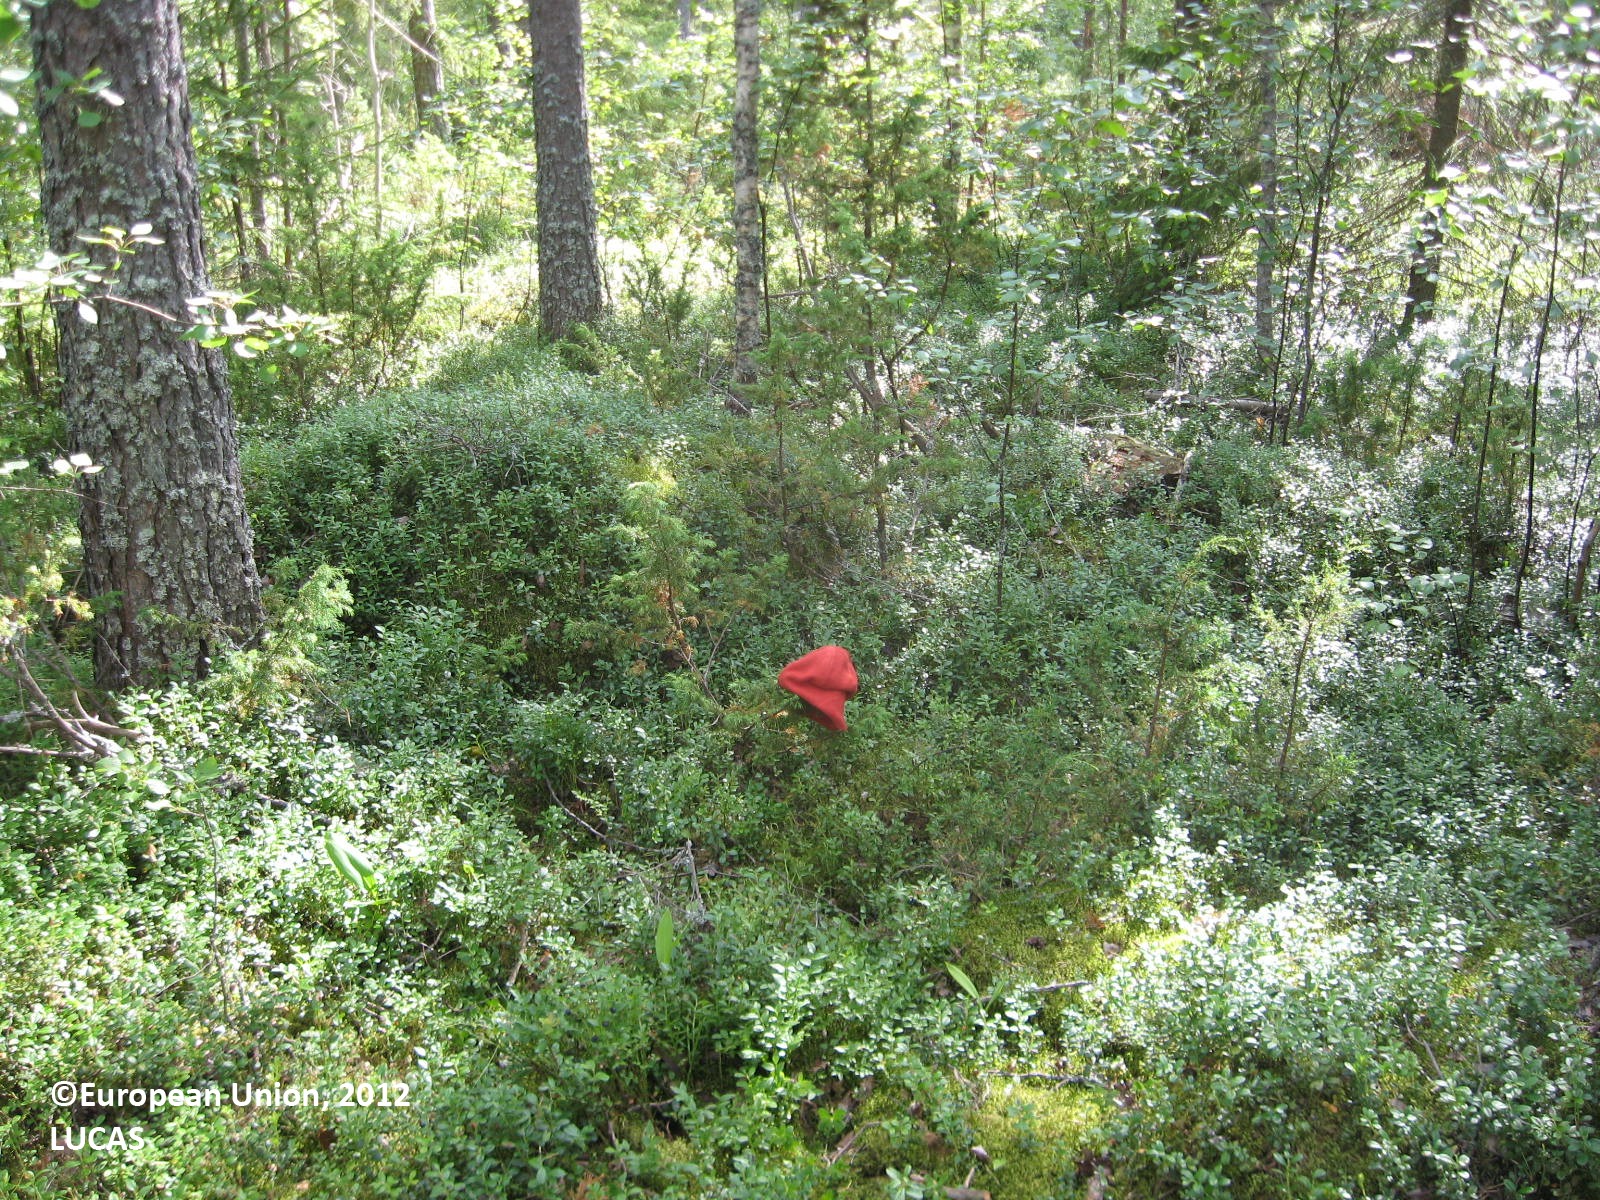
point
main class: Woodland
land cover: Pine dominated mixed woodland
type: boreal forest
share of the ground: > 75 %
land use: Forestry
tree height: > 5 m
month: July
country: FI
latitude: 62.0751
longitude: 21.5507
